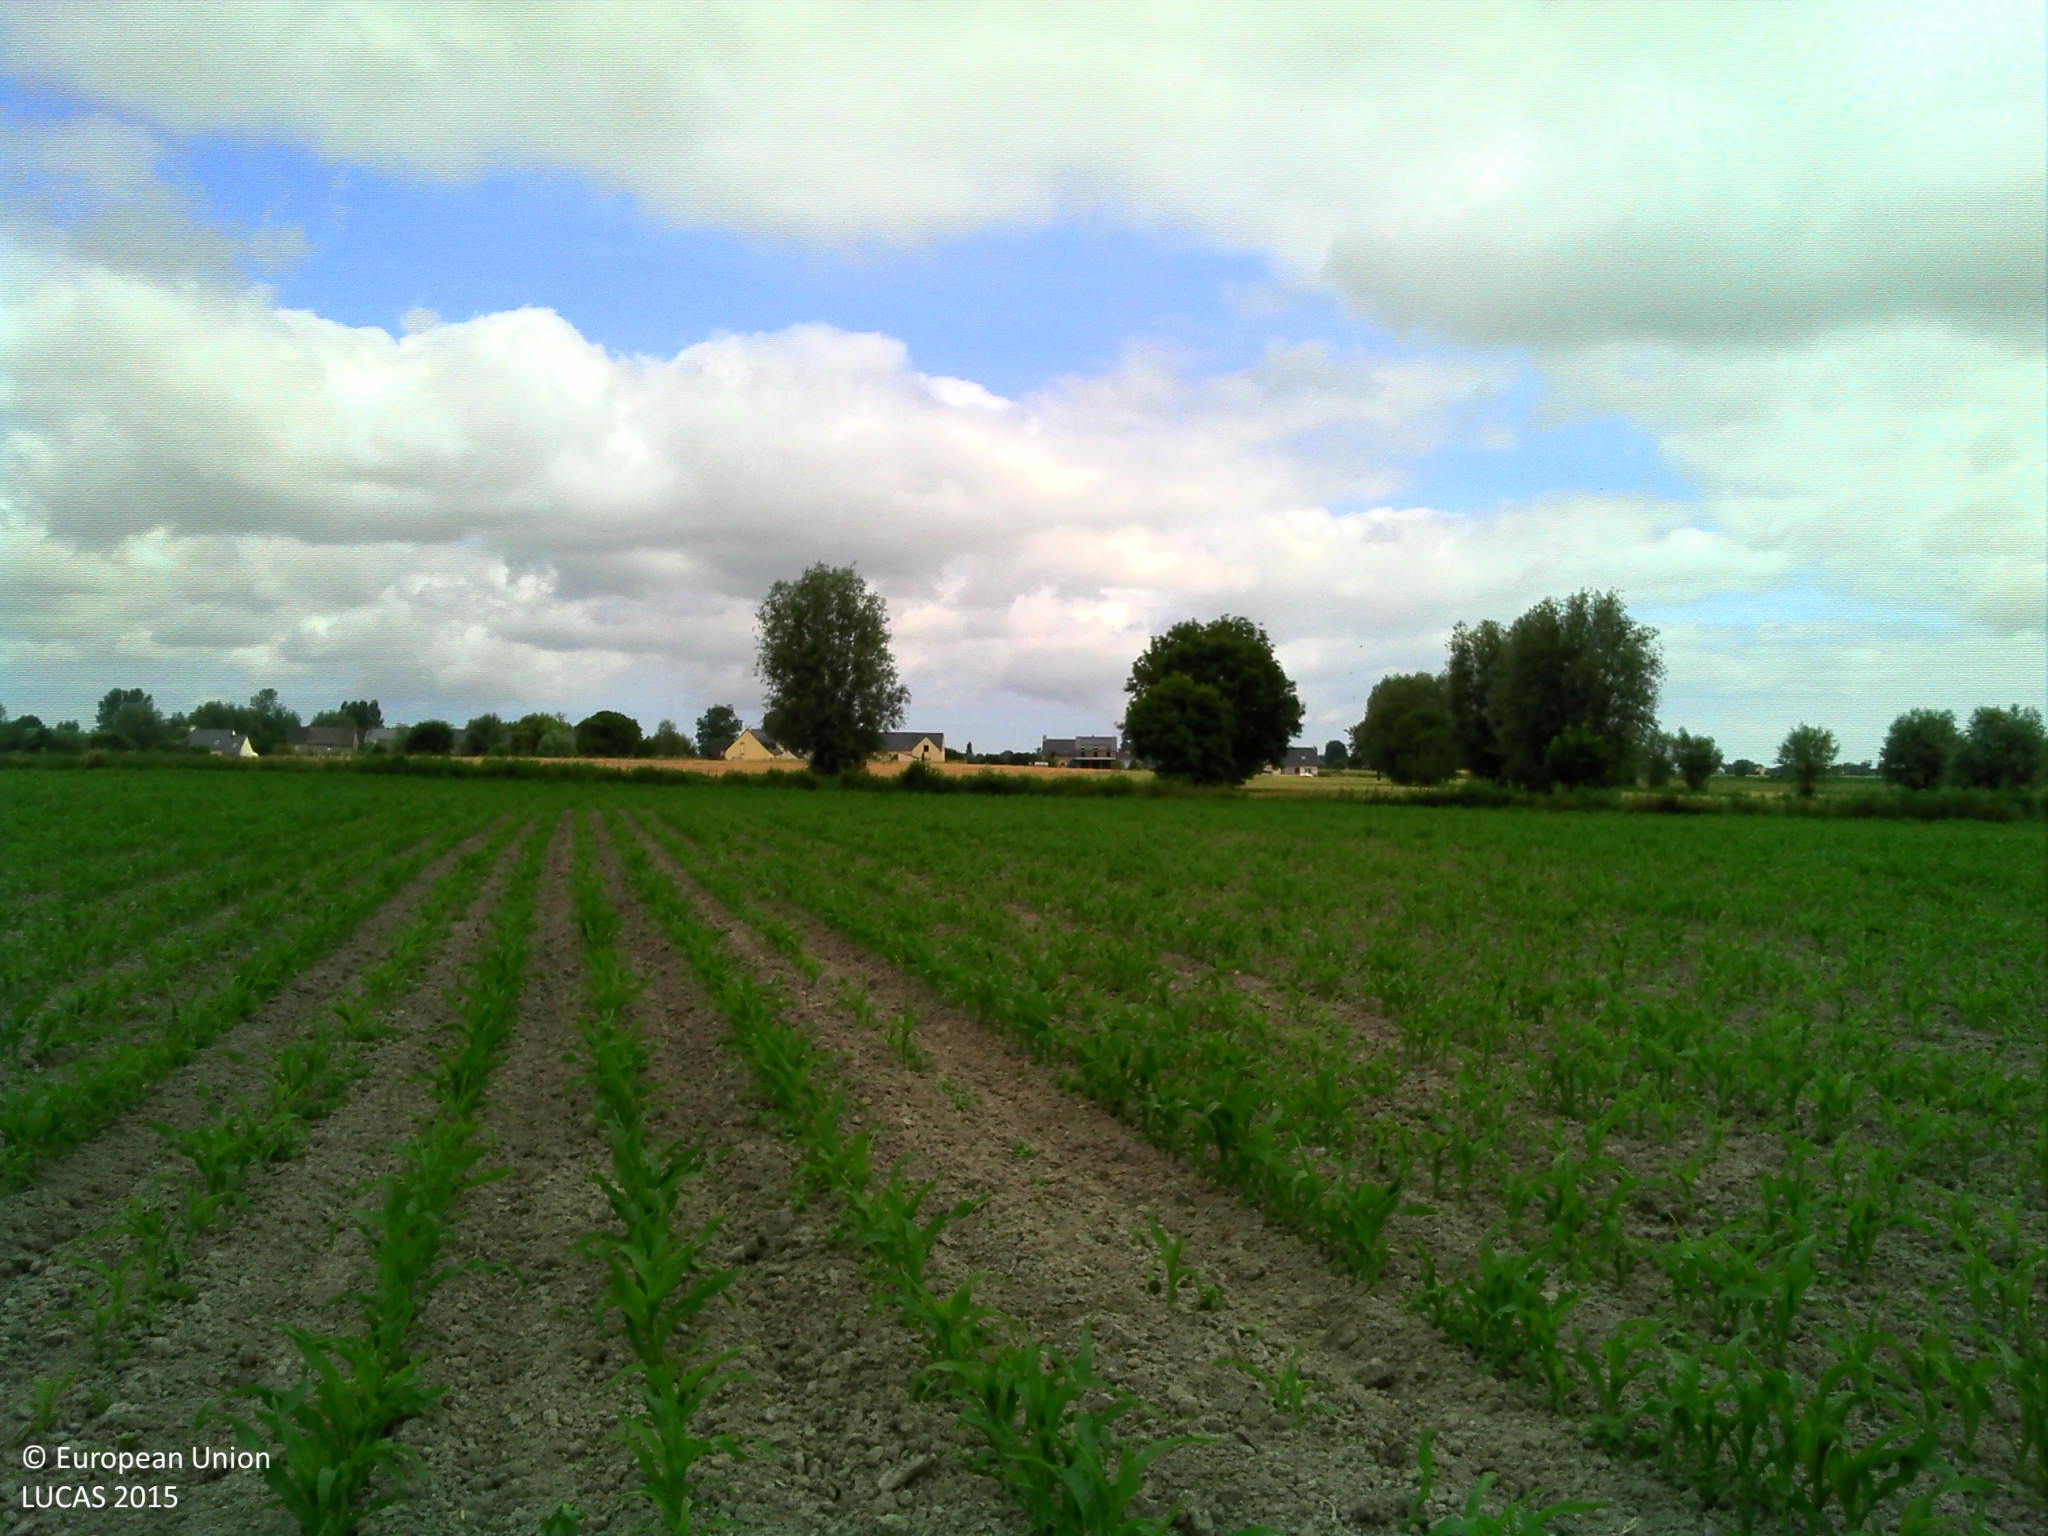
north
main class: Cropland
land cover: Maize
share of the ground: 10 - 25 %
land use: Agriculture (excluding fallow land and kitchen gardens)
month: June
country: FR
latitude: 48.5633
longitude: -1.8547
